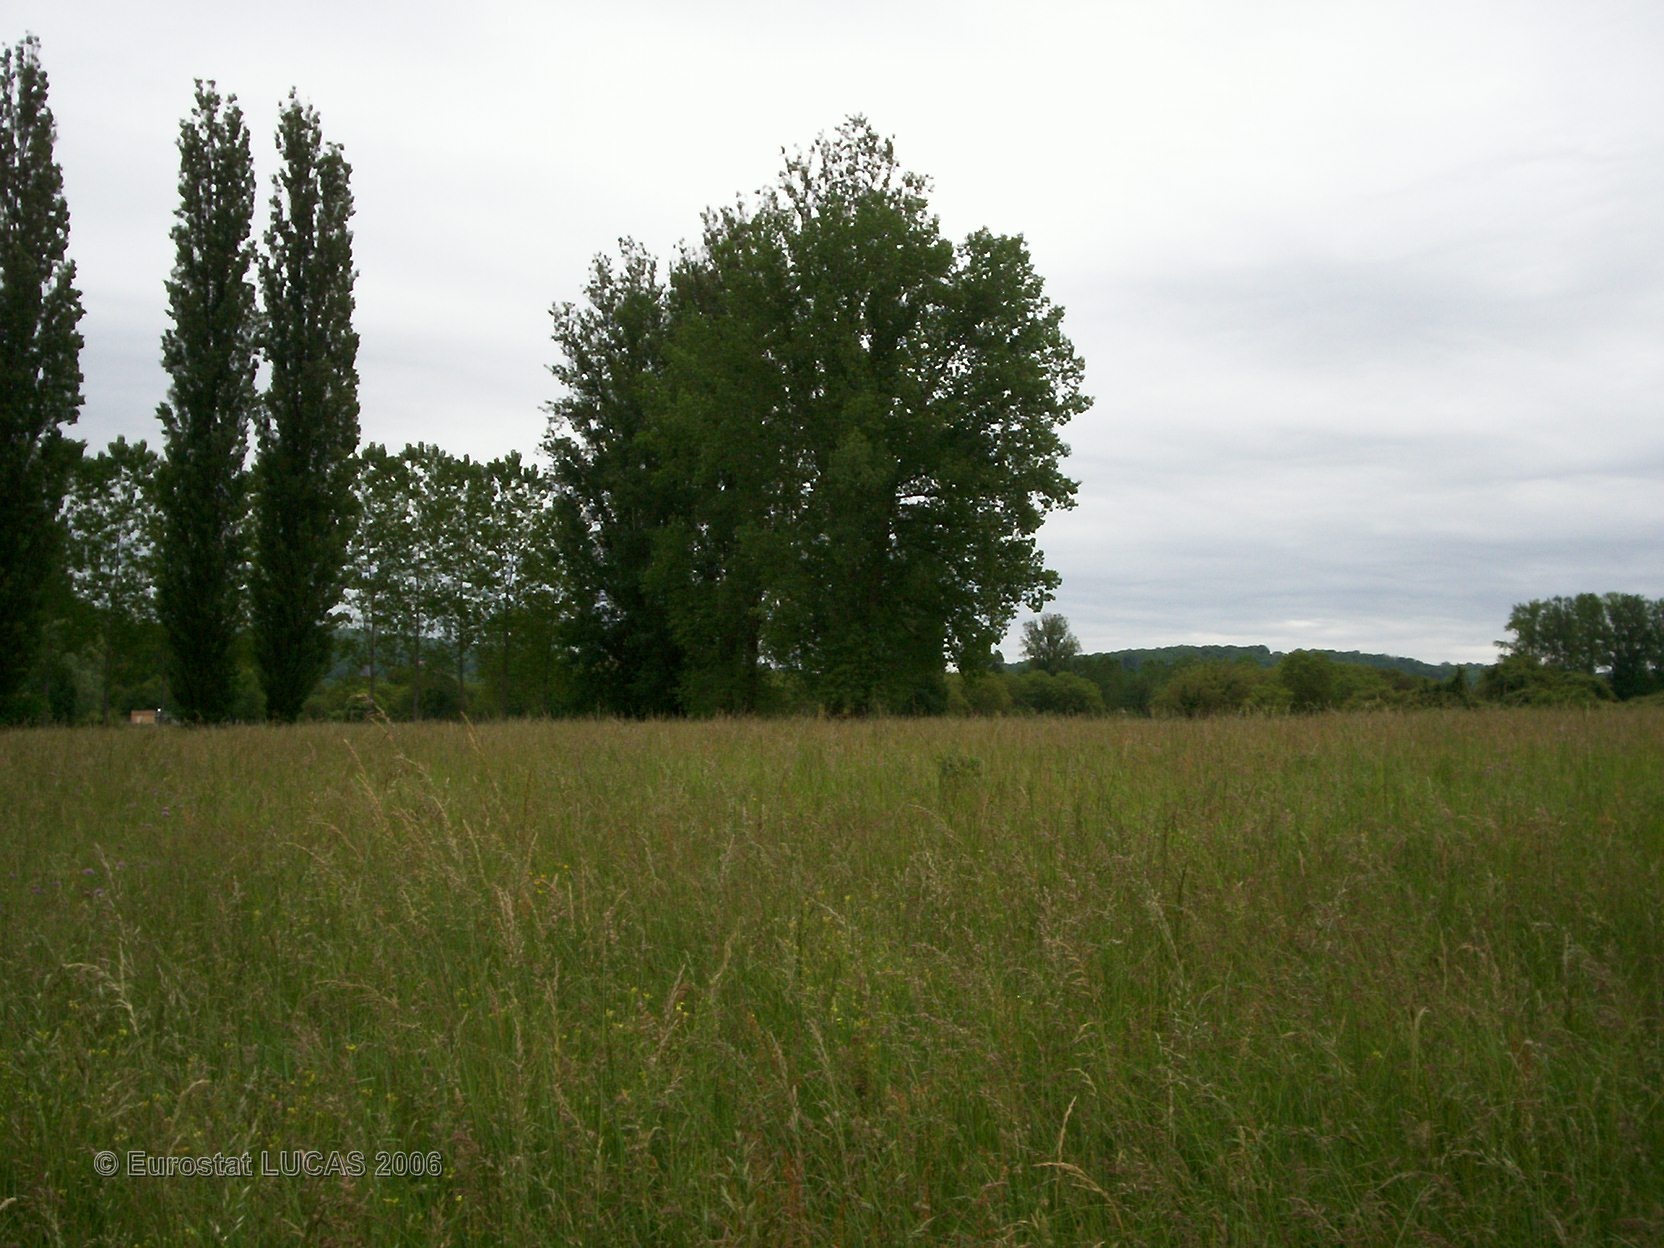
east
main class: Grassland
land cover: Grassland without tree/shrub cover
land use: Agriculture (excluding fallow land and kitchen gardens)
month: May
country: FR
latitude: 44.8591
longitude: 1.3524
